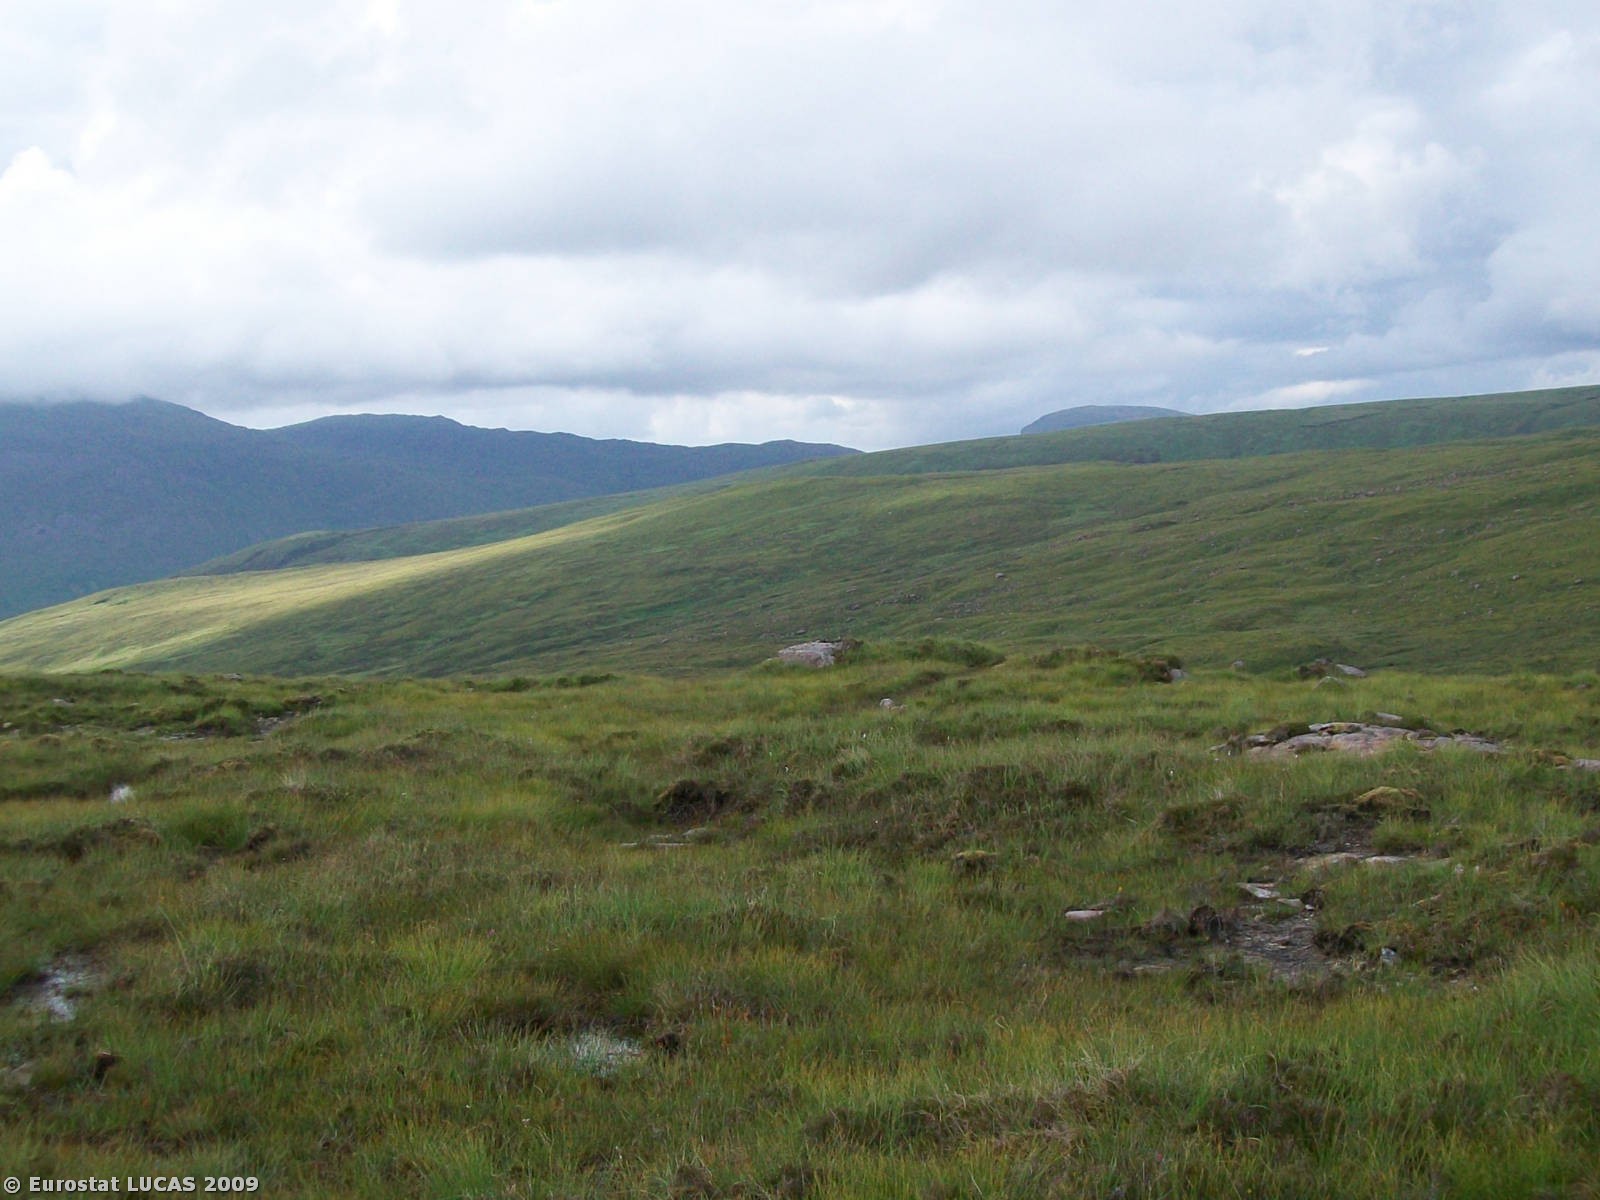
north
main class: Shrubland
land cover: Shrubland without tree cover
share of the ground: > 75 %
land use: Unused
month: July
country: GB
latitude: 57.4277
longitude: -5.7606
